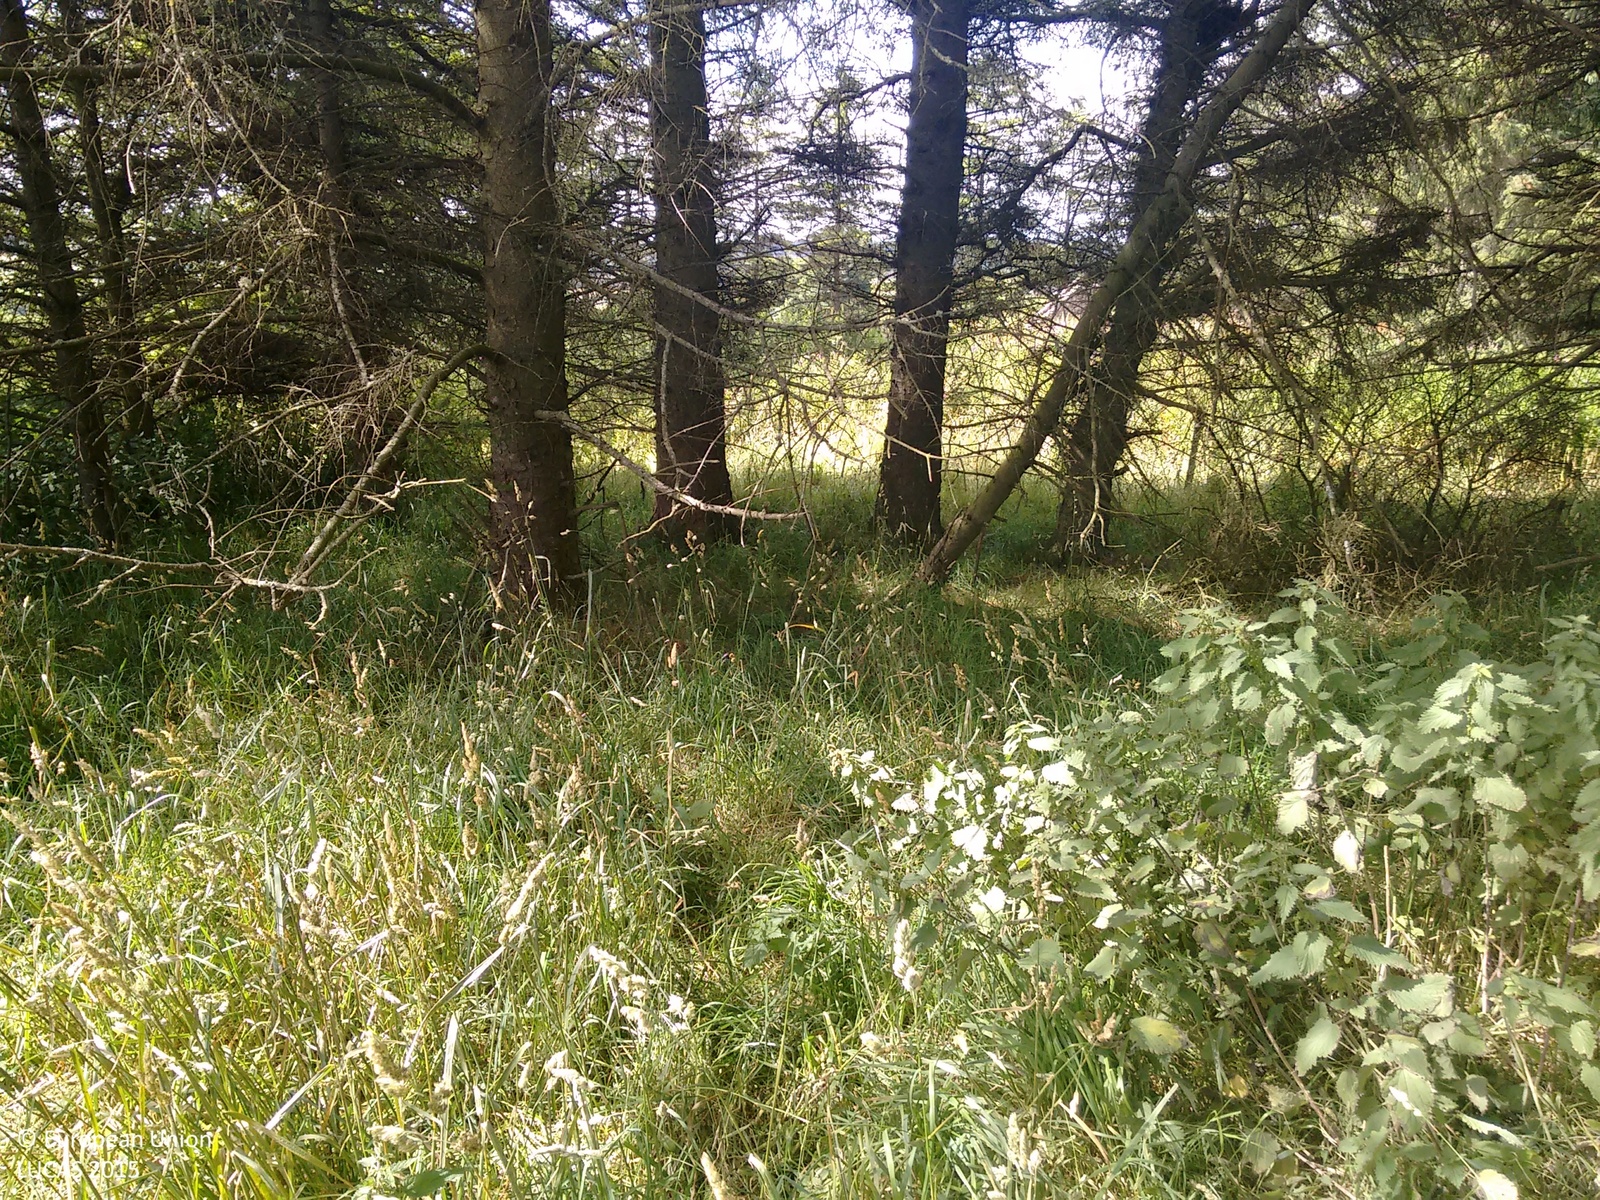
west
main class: Woodland
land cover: Spruce dominated coniferous woodland
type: exotic forest
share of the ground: > 75 %
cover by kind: coniferous forest trees 70 %, herbaceous plants 10 %, broadleaved forest trees 5 %, shrubs 5 %
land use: Agriculture (excluding fallow land and kitchen gardens)
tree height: > 5 m
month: August
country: GB
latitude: 57.5679
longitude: -2.9838
